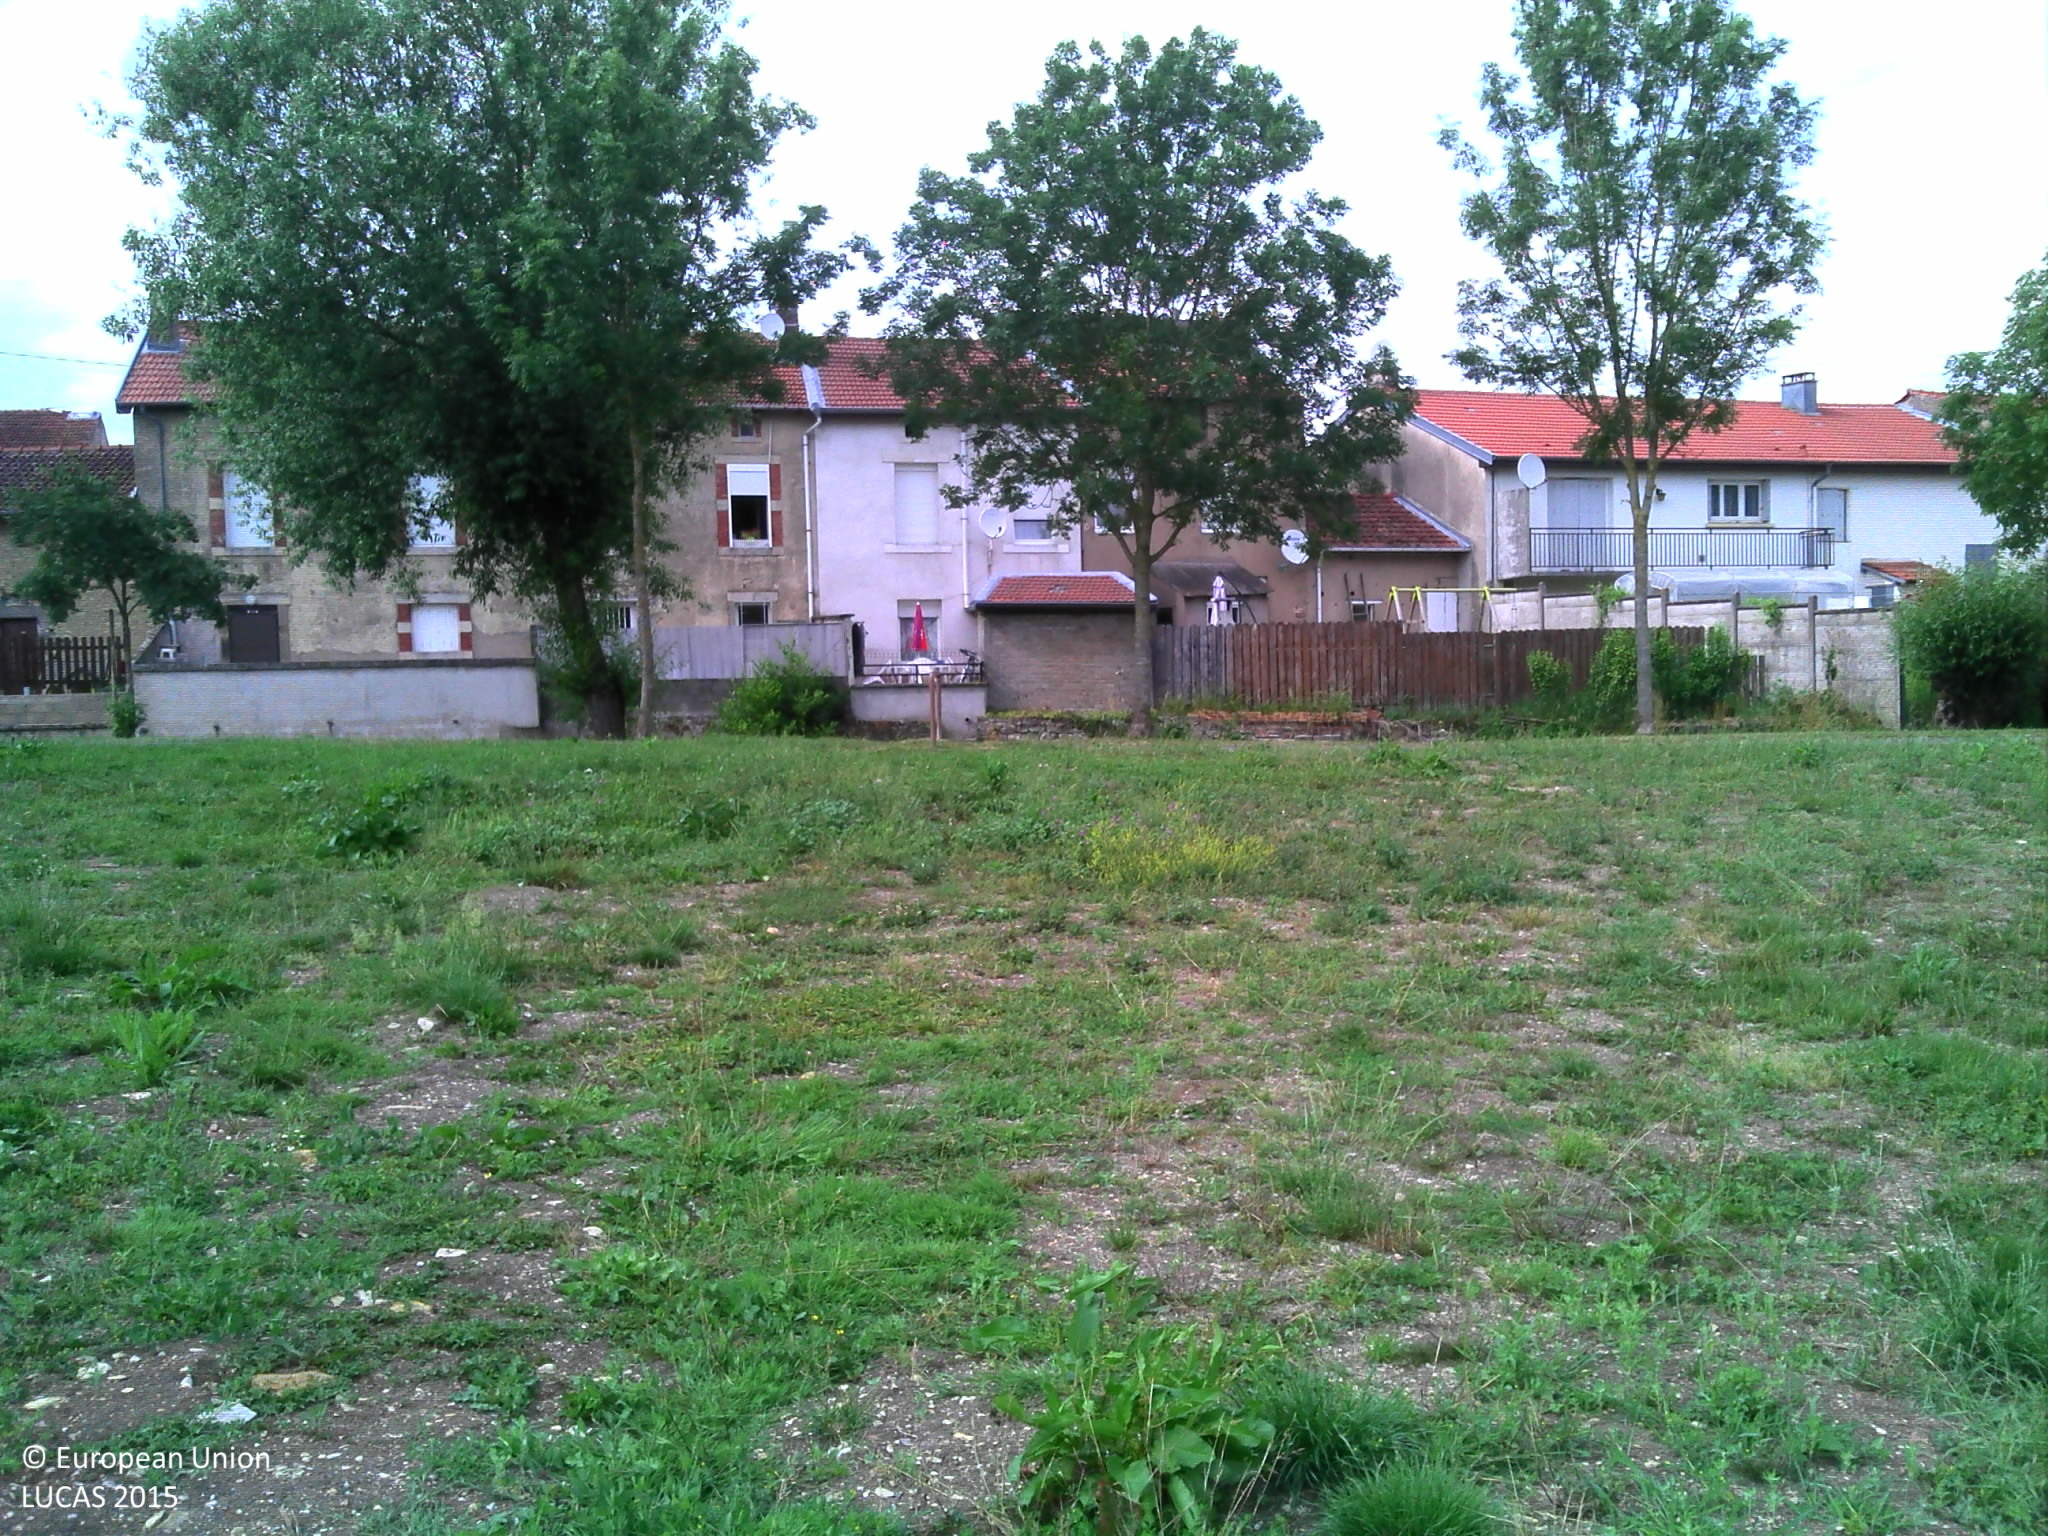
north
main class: Grassland
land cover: Spontaneously vegetated surfaces
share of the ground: > 75 %
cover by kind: herbaceous plants 100 %
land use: Amenities, museums, leisure
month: June
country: FR
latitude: 48.6538
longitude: 6.4844
